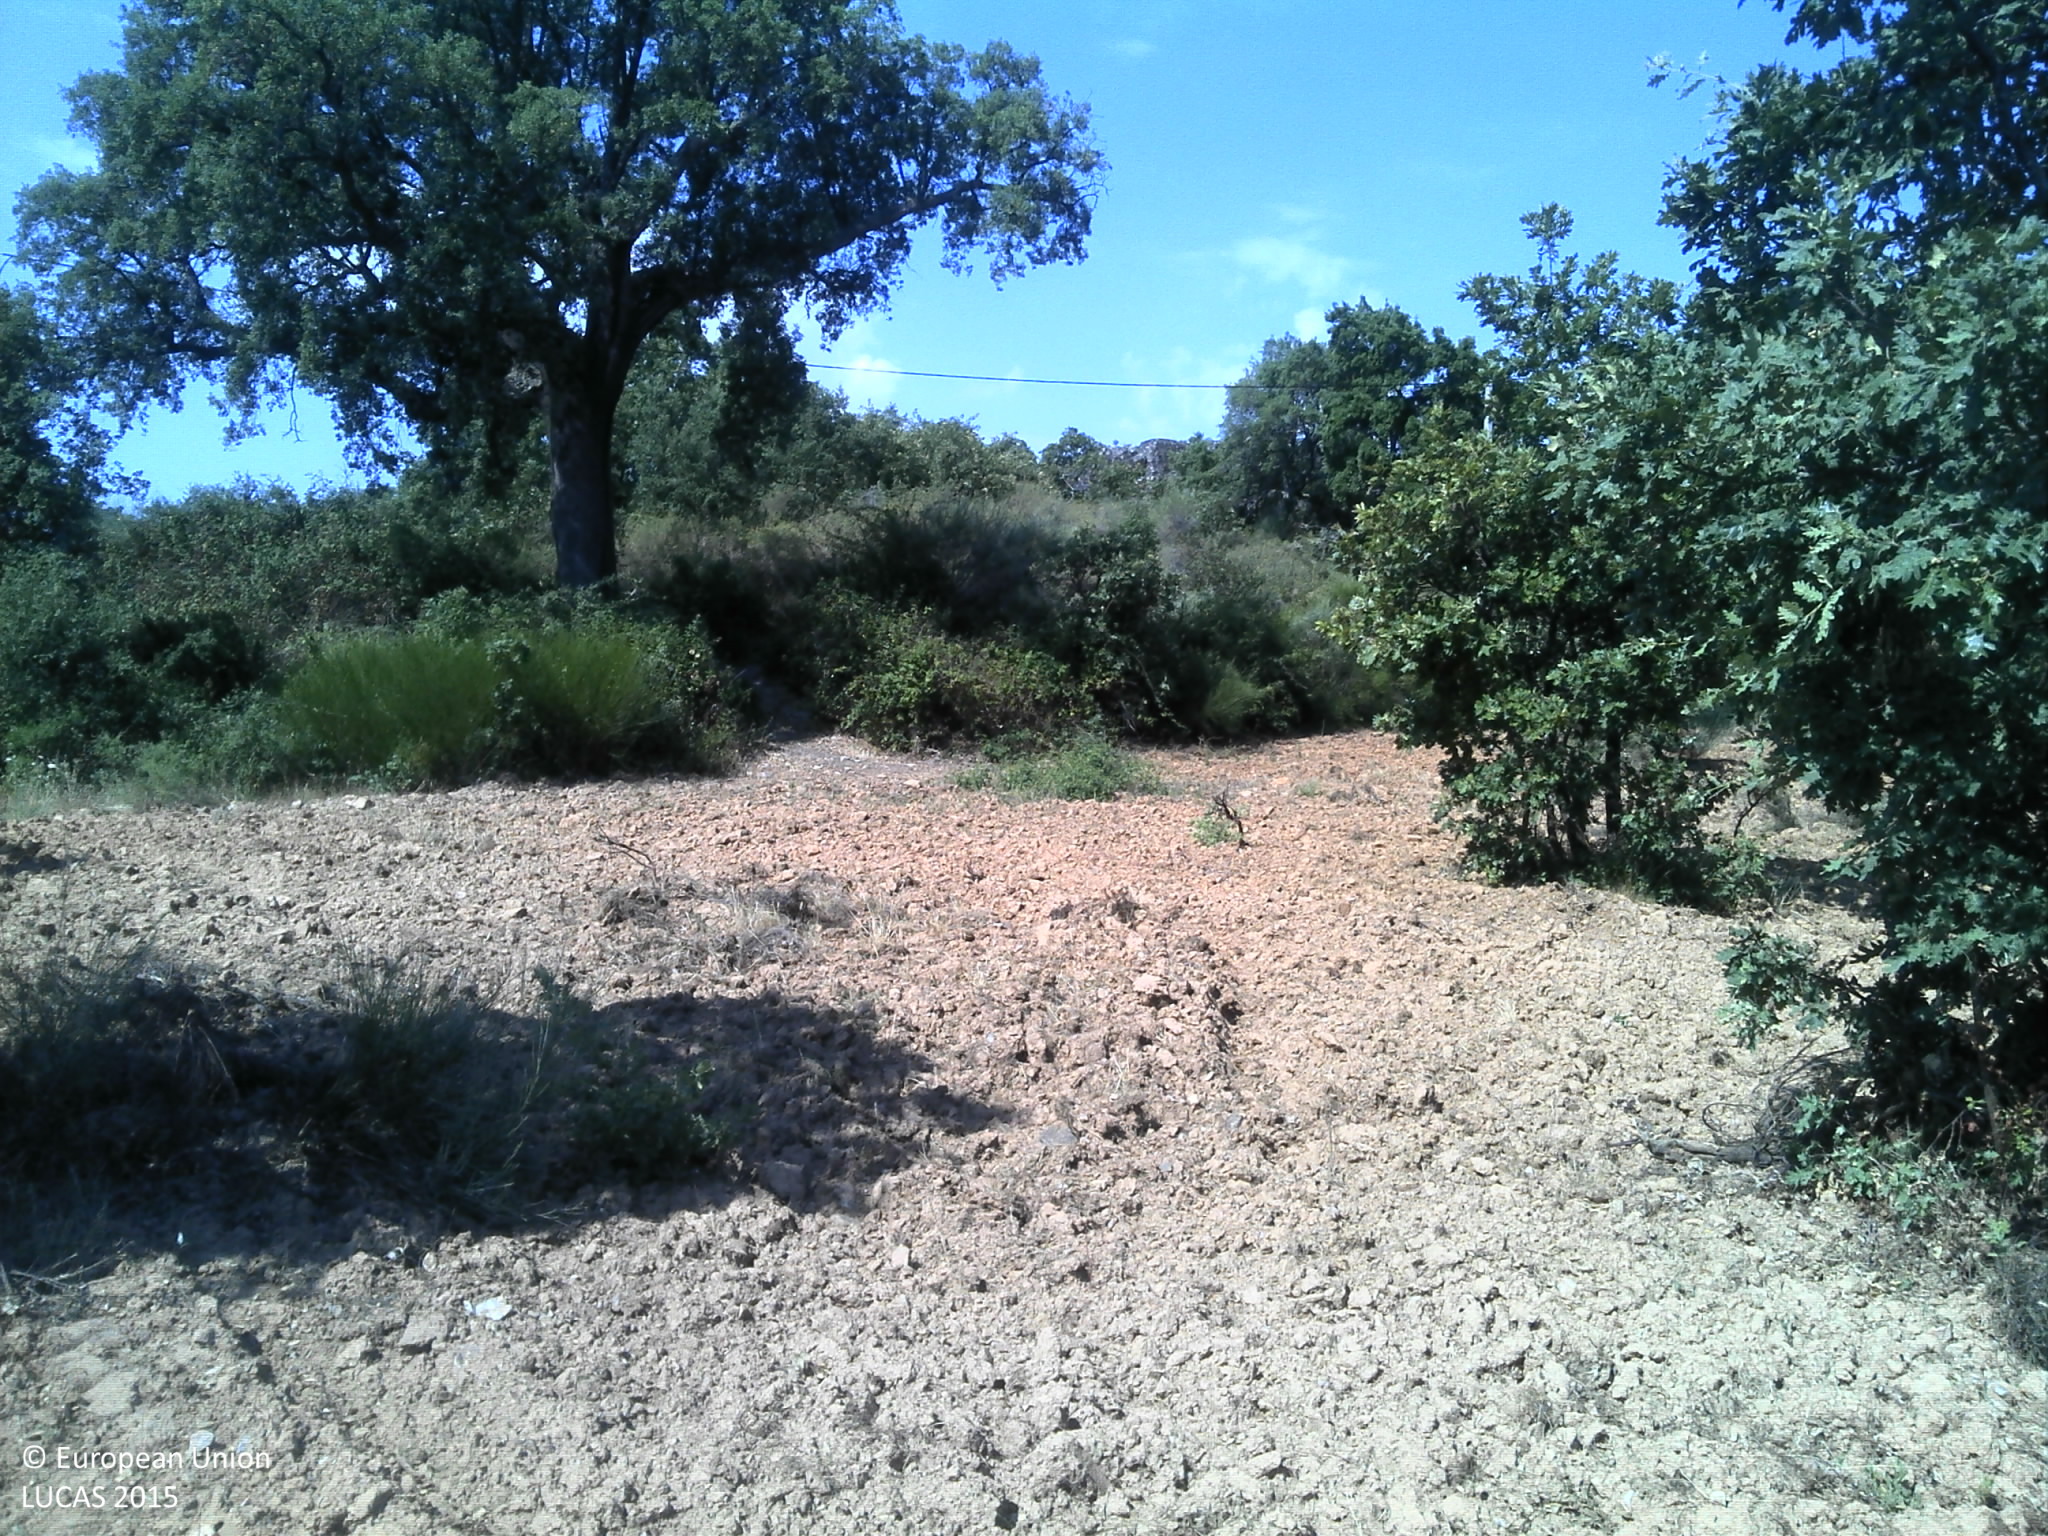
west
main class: Woodland
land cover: Broadleaved woodland
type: acidophilous oak and oak-birch forest
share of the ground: 25 - 50 %
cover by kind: broadleaved forest trees 50 %, unconsolidated bare surface 40 %, herbaceous plants 5 %
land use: Forestry
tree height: > 5 m
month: June
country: PT
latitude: 40.1634
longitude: -7.1570
